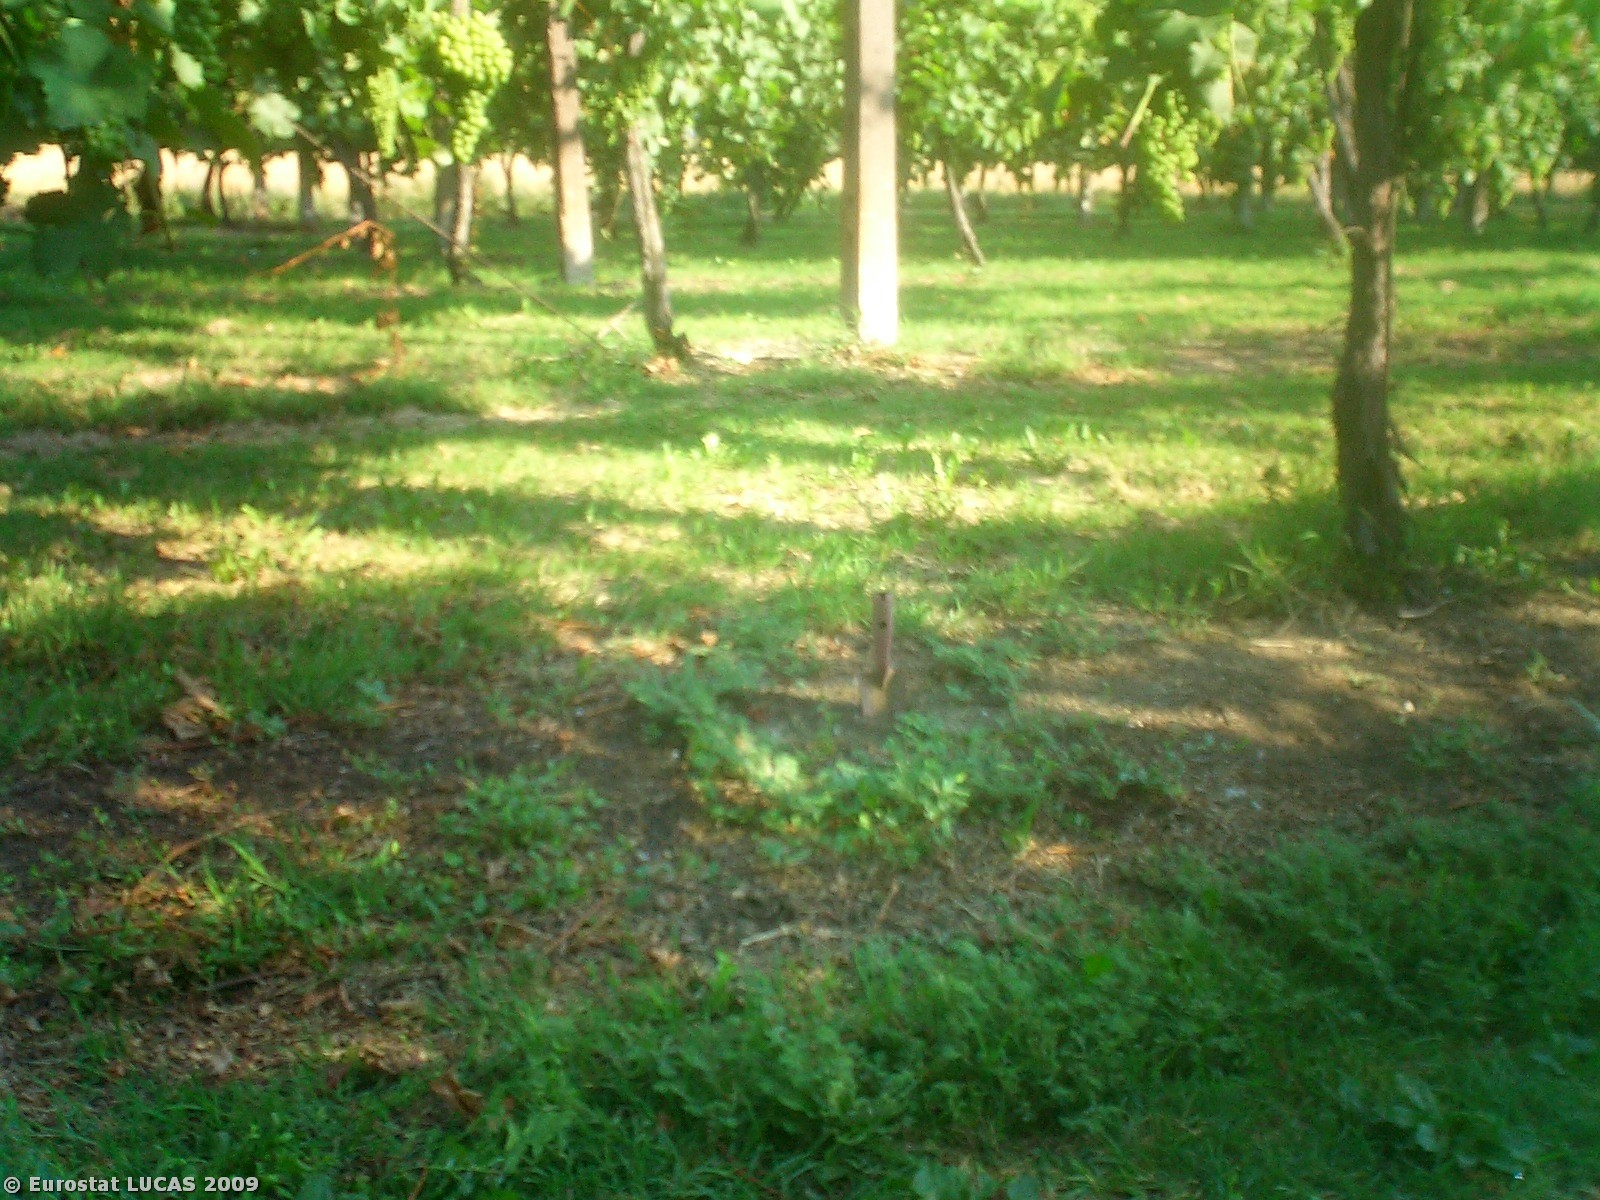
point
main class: Cropland
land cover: Vineyards
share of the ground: 50 - 75 %
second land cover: Grassland with sparse tree/shrub cover
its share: 50 - 75 %
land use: Agriculture (excluding fallow land and kitchen gardens)
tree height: < 5 m
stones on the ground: < 10 %
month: July
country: IT
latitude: 44.2959
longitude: 11.9634
